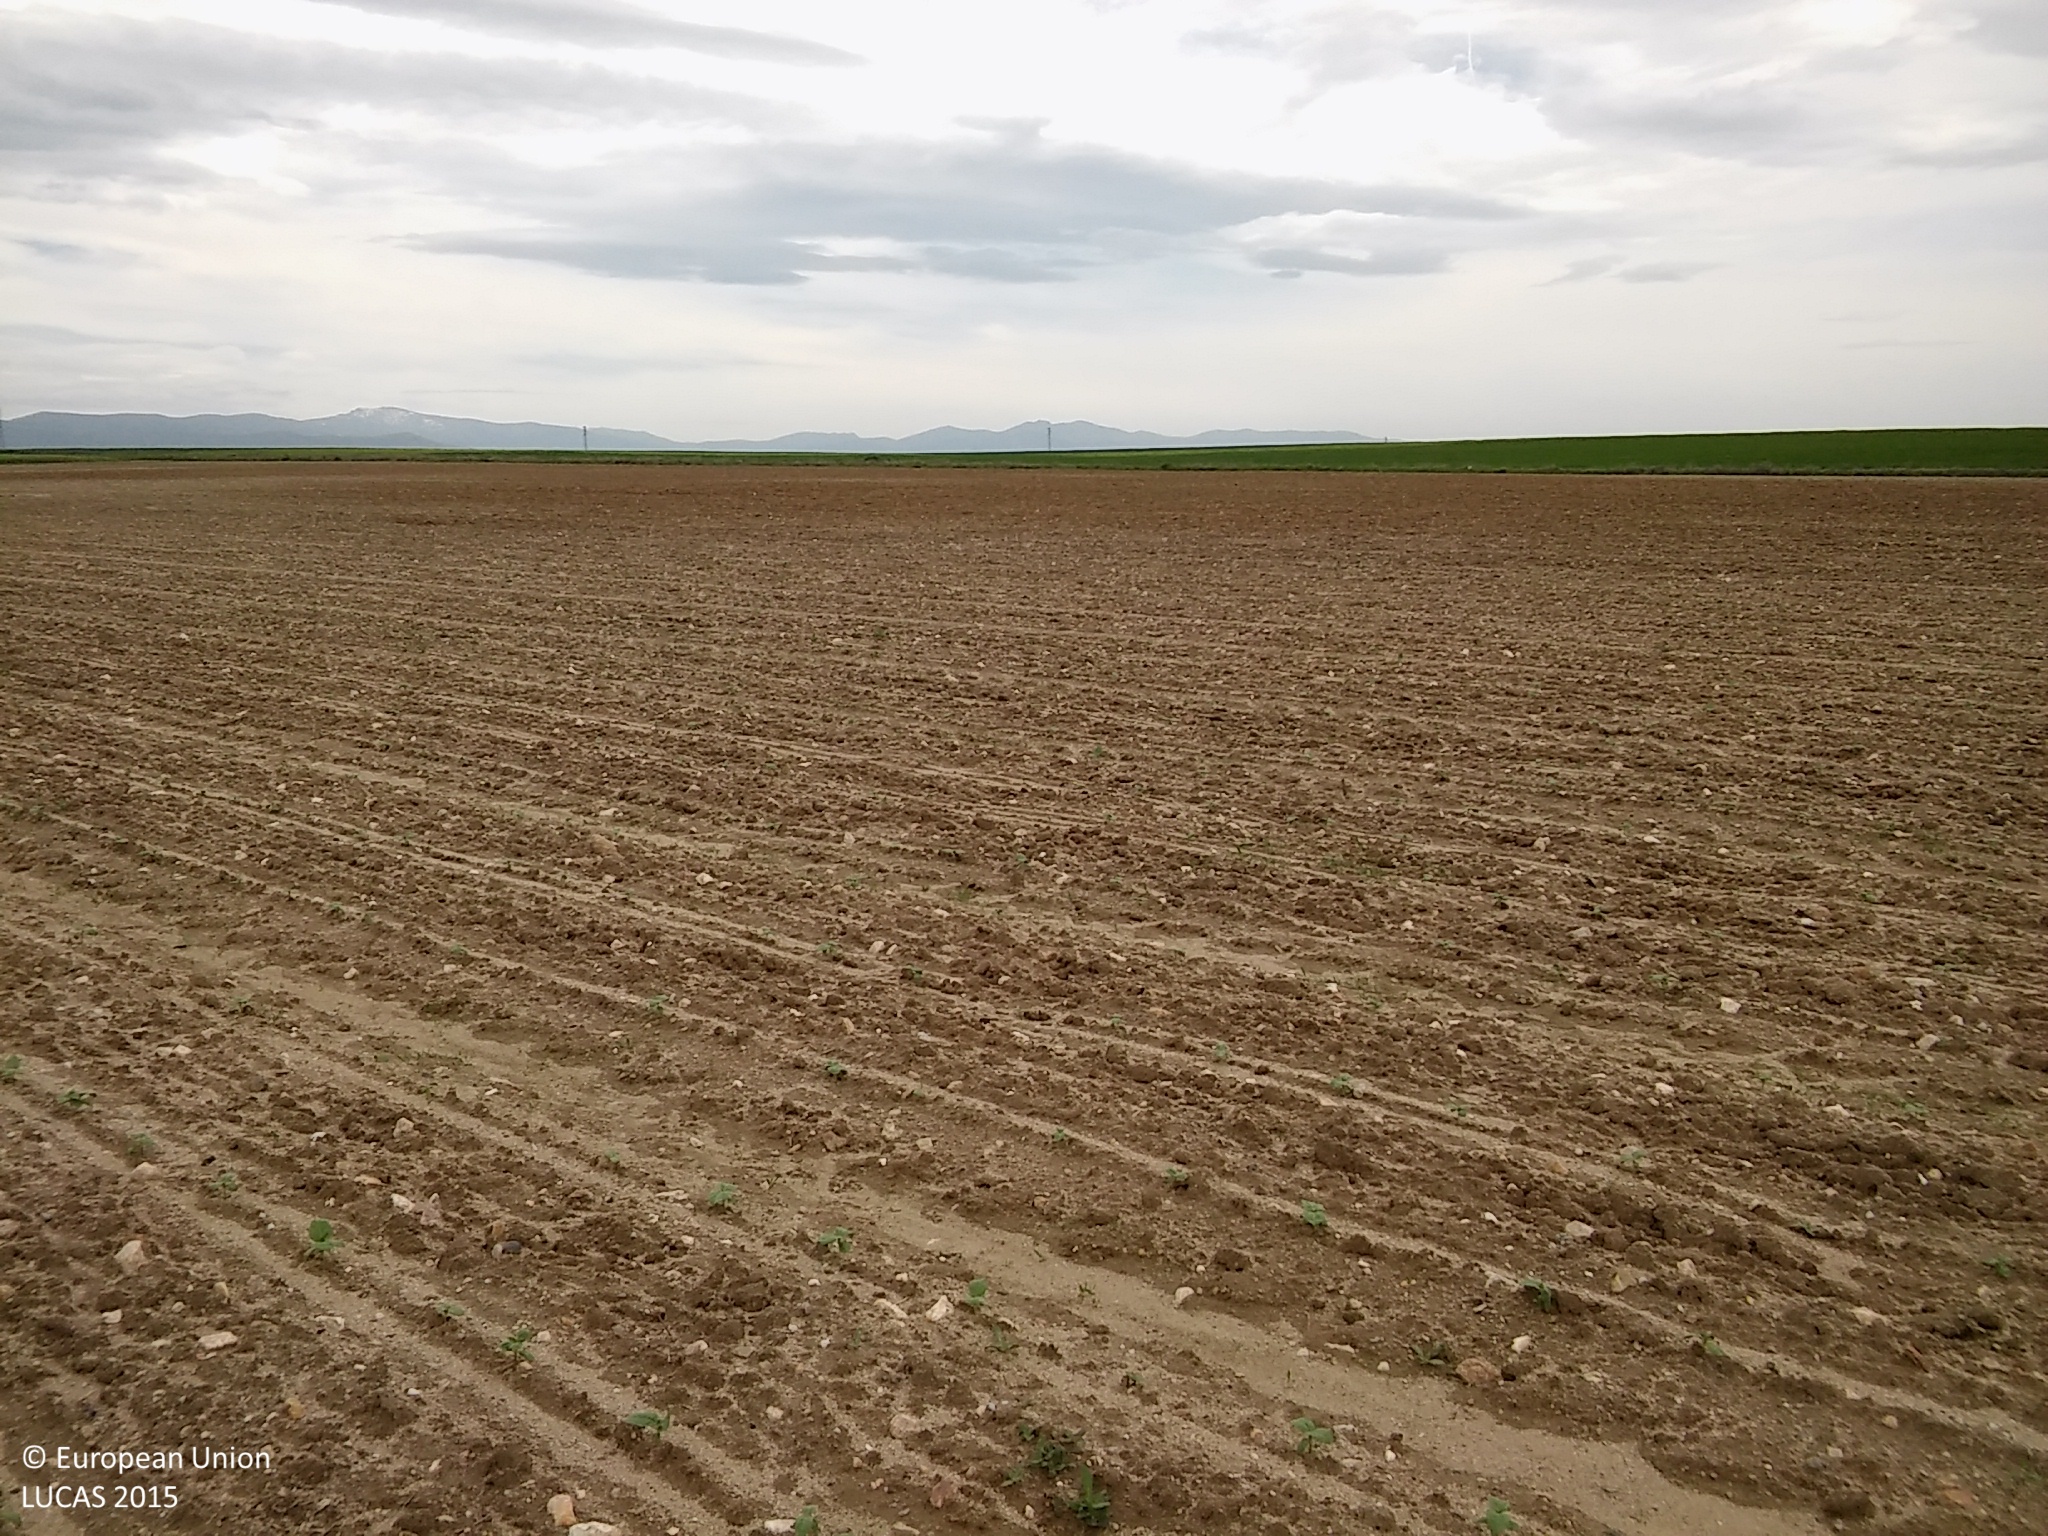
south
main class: Cropland
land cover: Sunflower
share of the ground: < 10 %
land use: Agriculture (excluding fallow land and kitchen gardens)
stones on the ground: 25 - 50 %
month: May
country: ES
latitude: 41.1493
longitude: -4.1008
